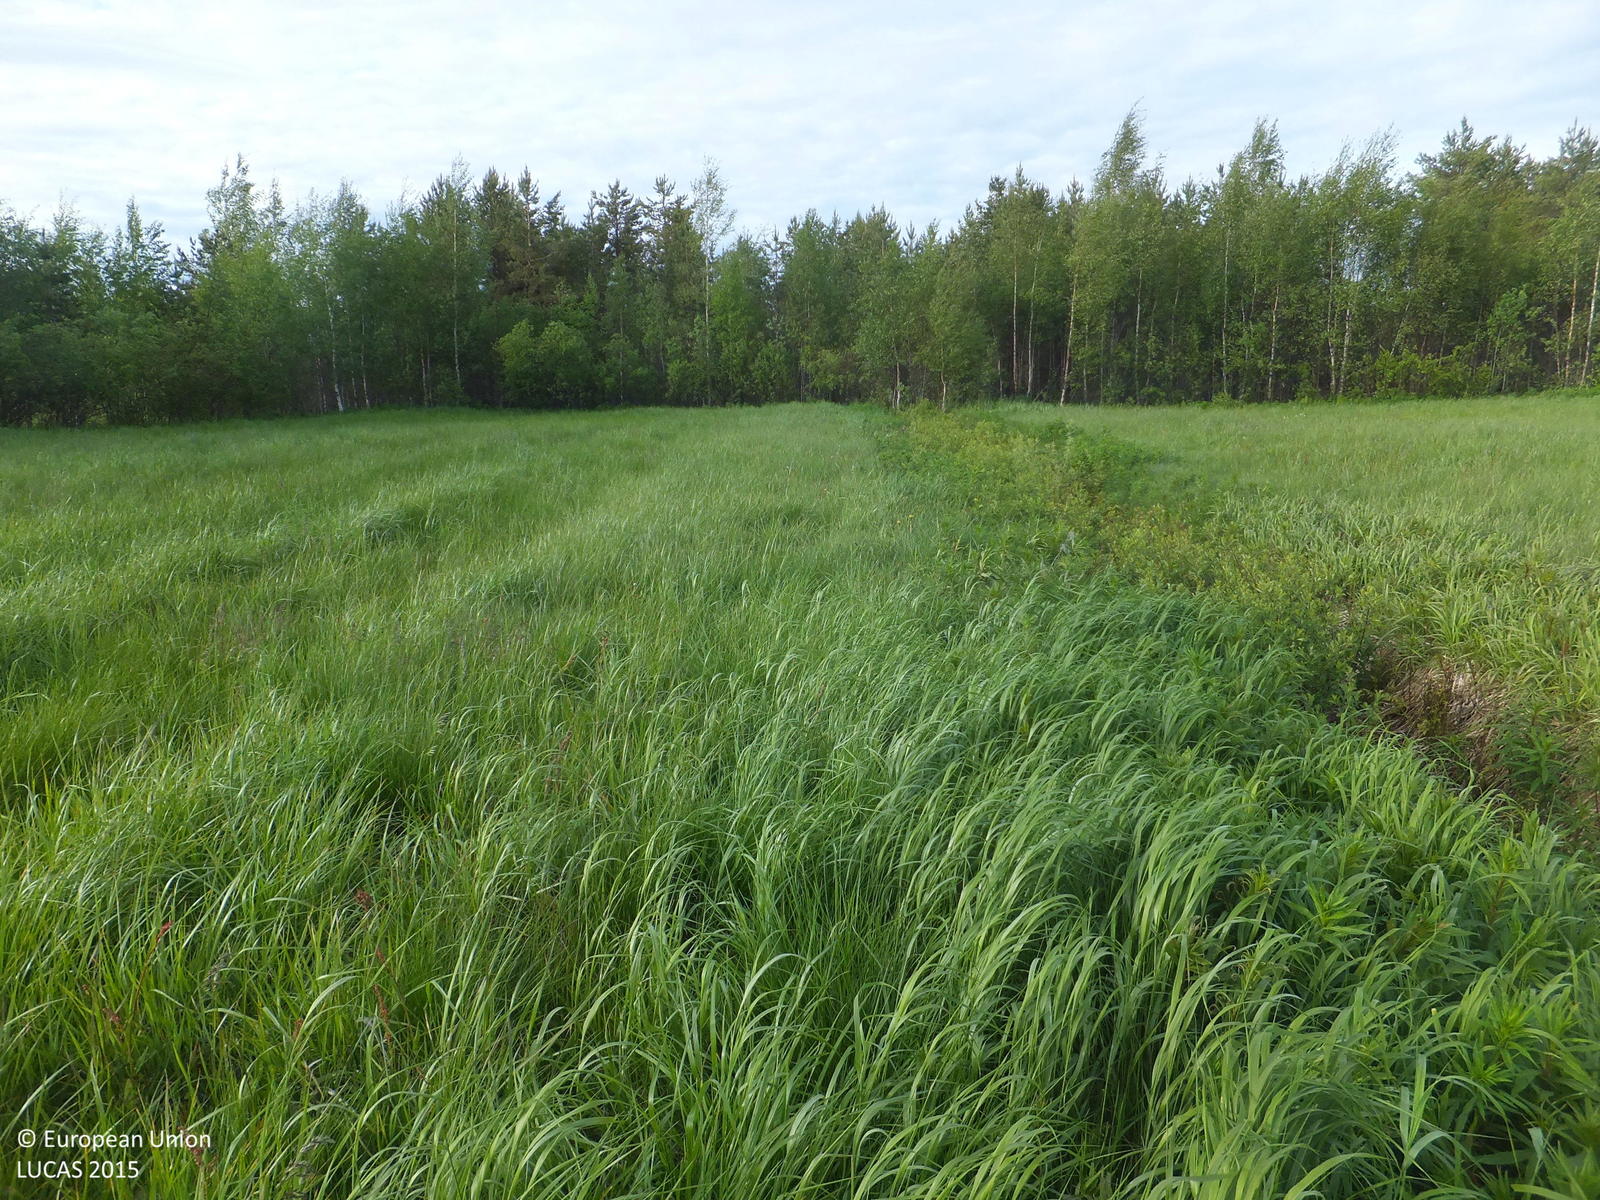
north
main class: Cropland
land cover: Temporary grasslands
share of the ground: > 75 %
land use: Agriculture (excluding fallow land and kitchen gardens)
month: June
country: FI
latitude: 63.6777
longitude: 24.2428
